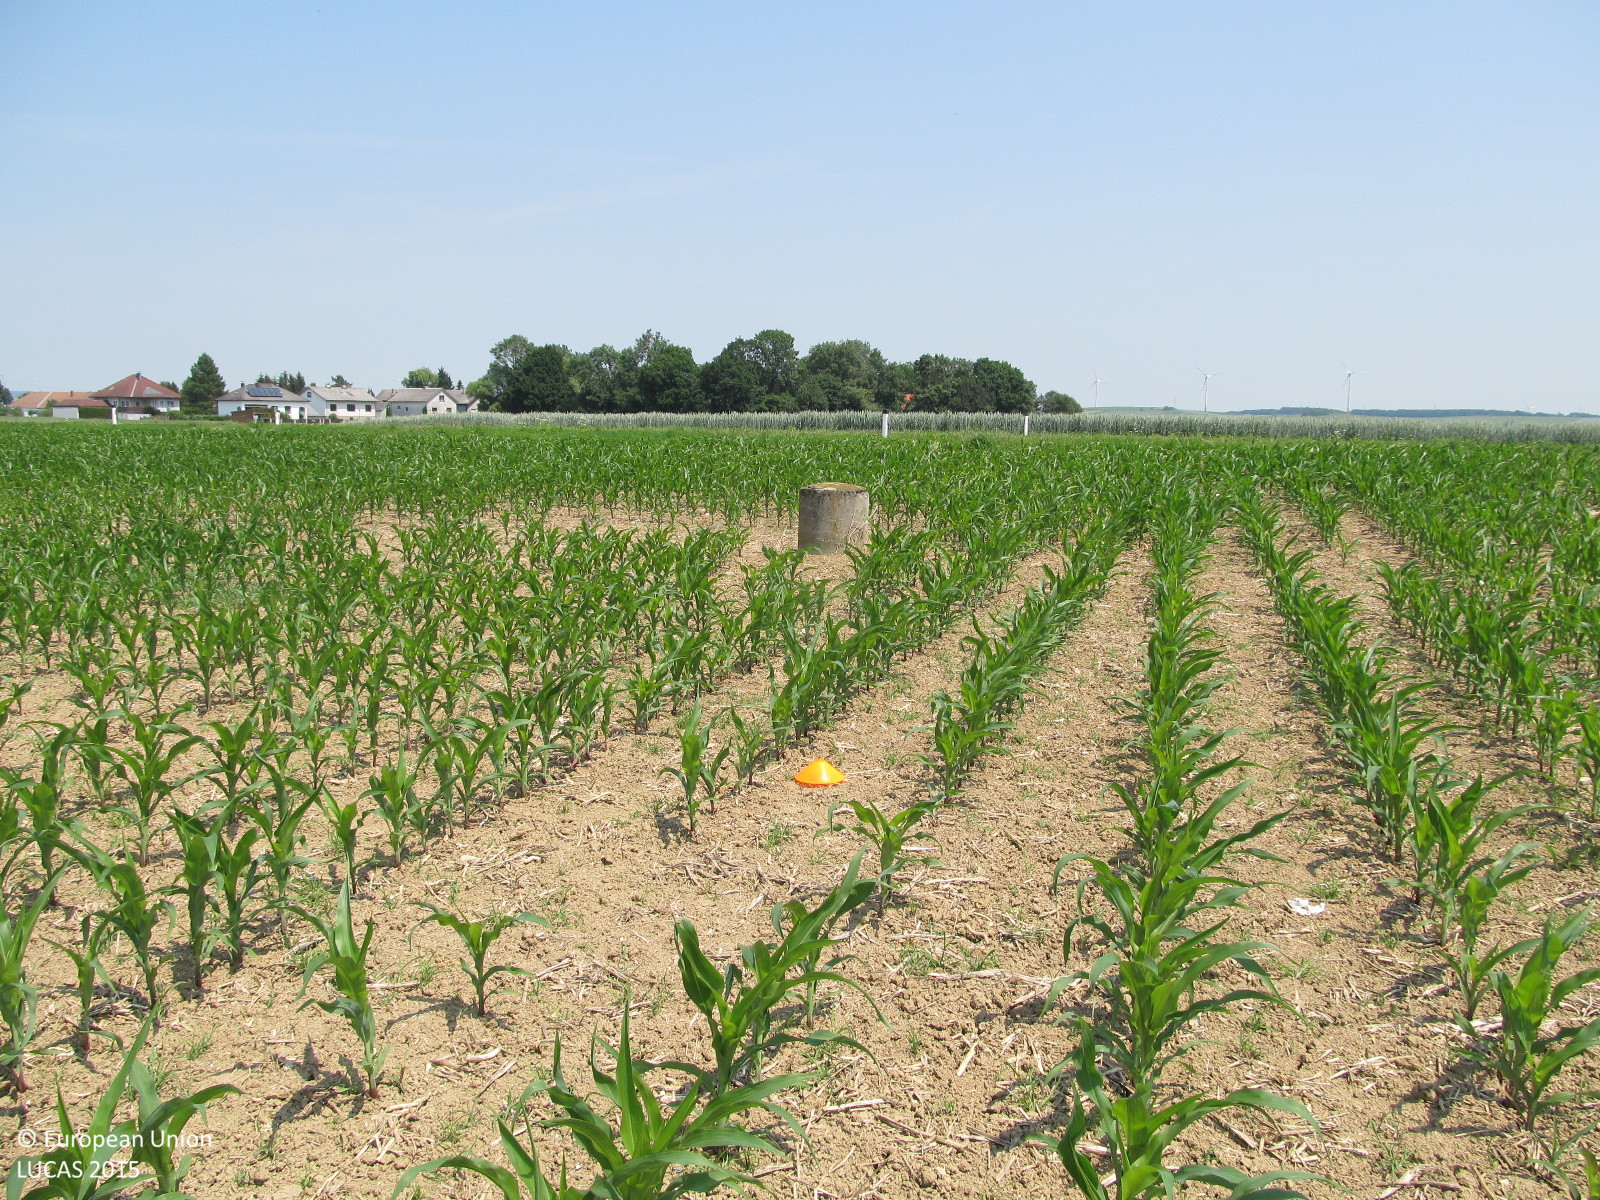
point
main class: Cropland
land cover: Maize
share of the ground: 25 - 50 %
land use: Agriculture (excluding fallow land and kitchen gardens)
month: June
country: AT
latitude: 48.2427
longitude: 15.6179
